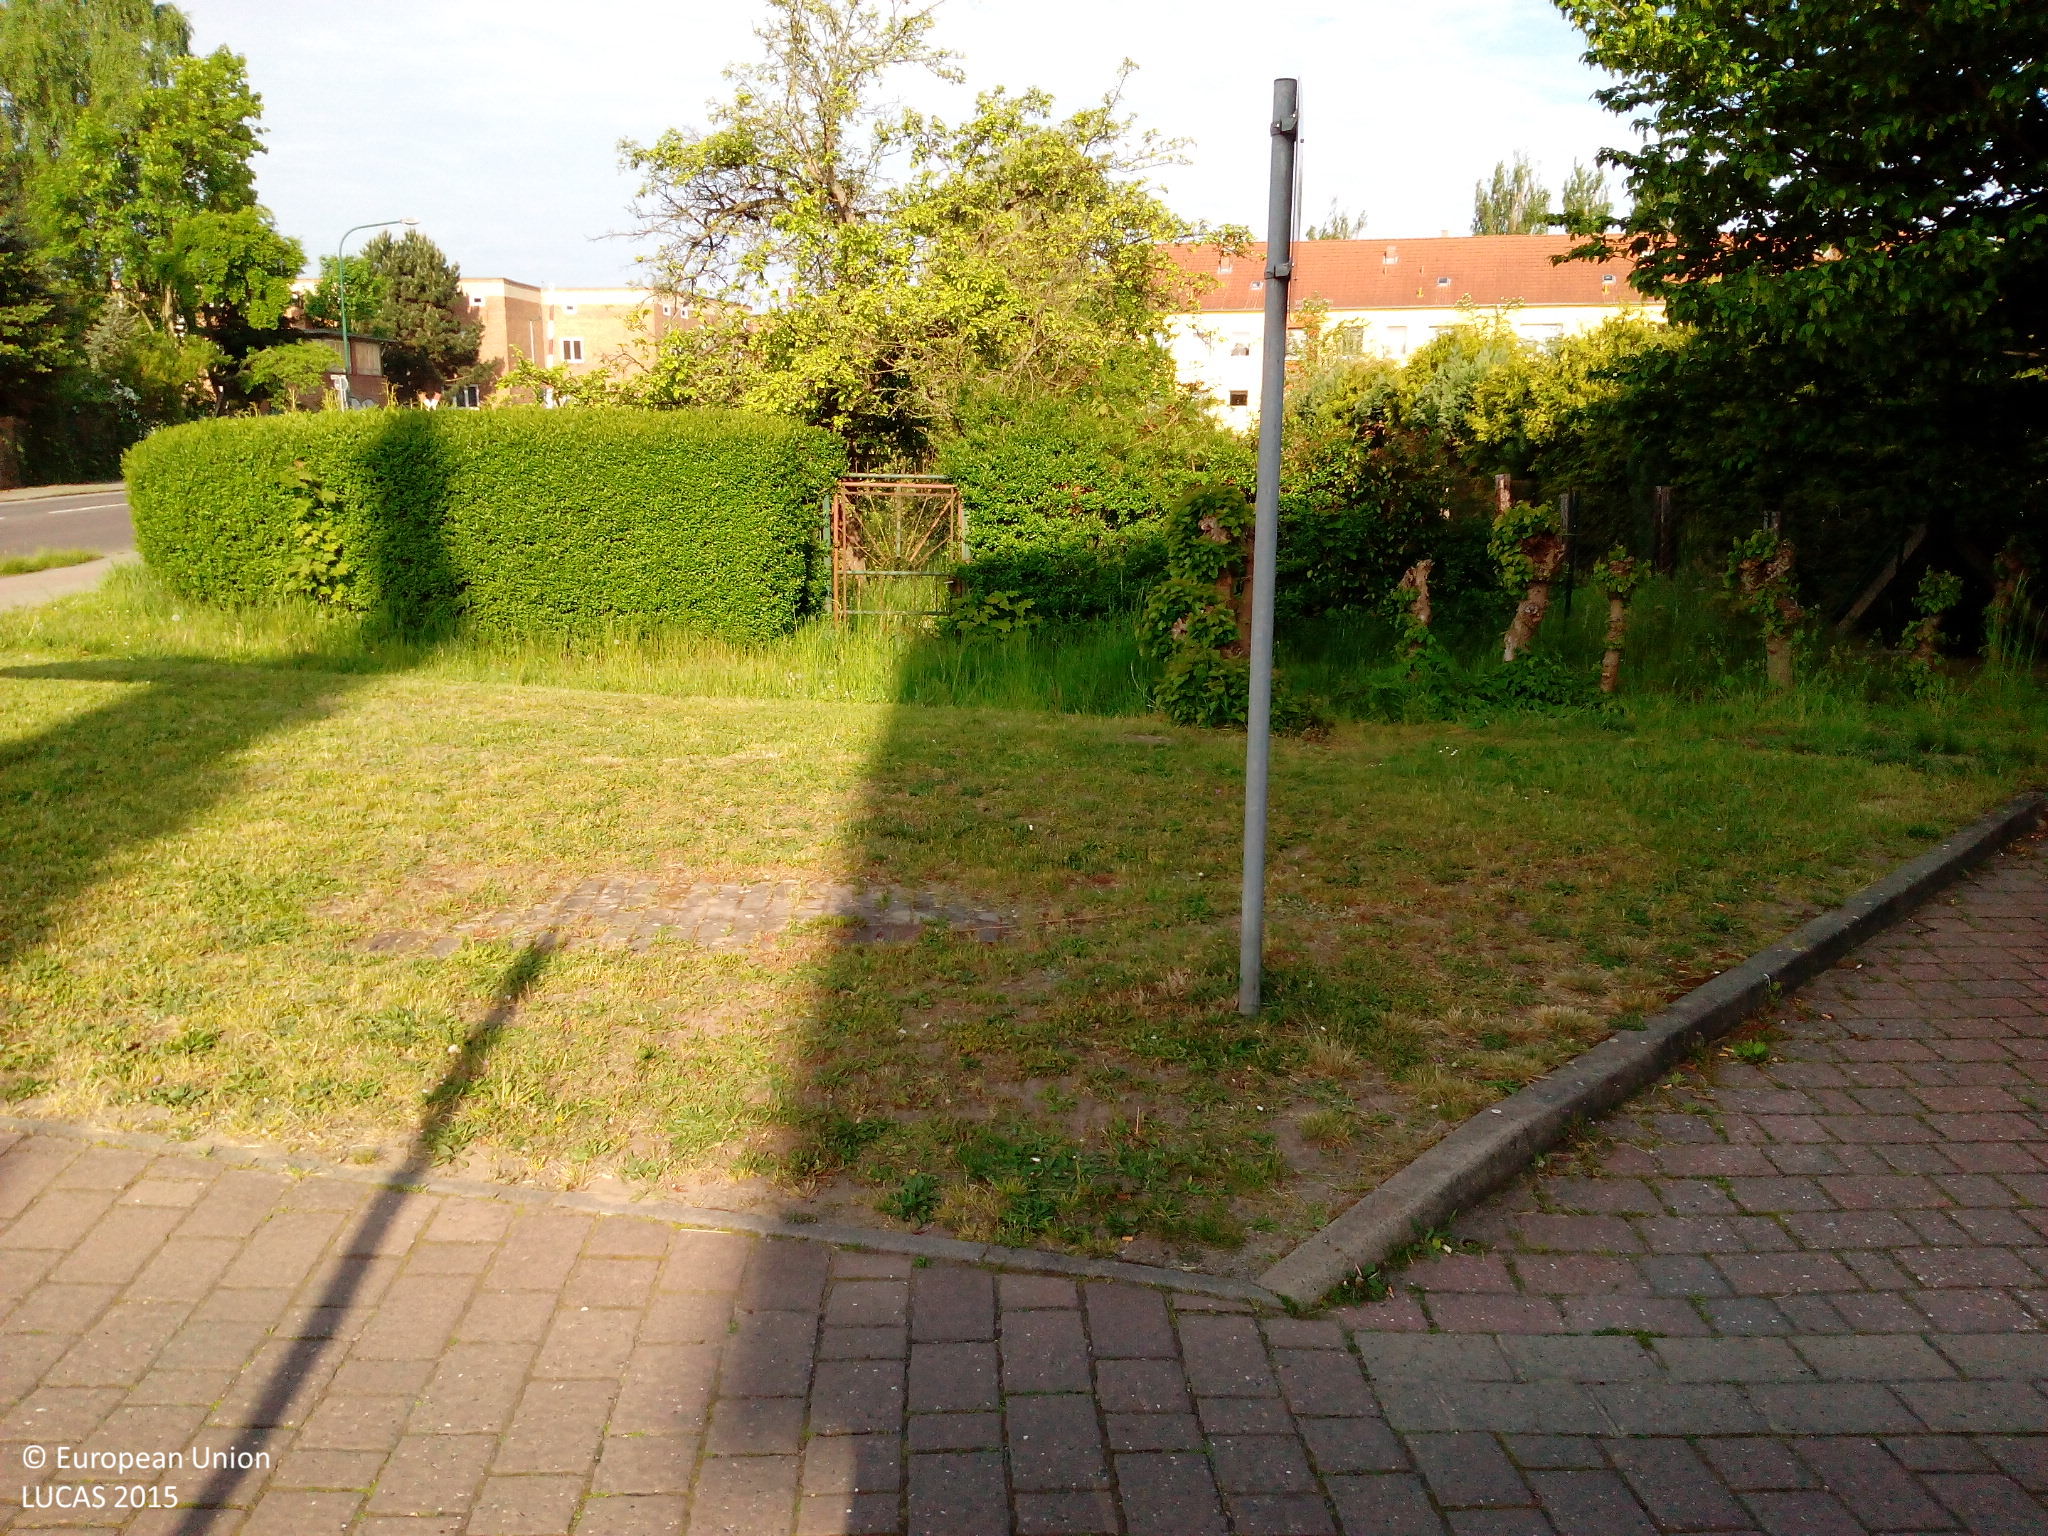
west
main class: Grassland
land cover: Grassland with sparse tree/shrub cover
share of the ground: > 75 %
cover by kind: herbaceous plants 80 %, coniferous forest trees 5 %, lichens and mosses 5 %, unconsolidated bare surface 5 %
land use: Community services
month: May
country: DE
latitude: 52.8573
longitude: 11.1431
